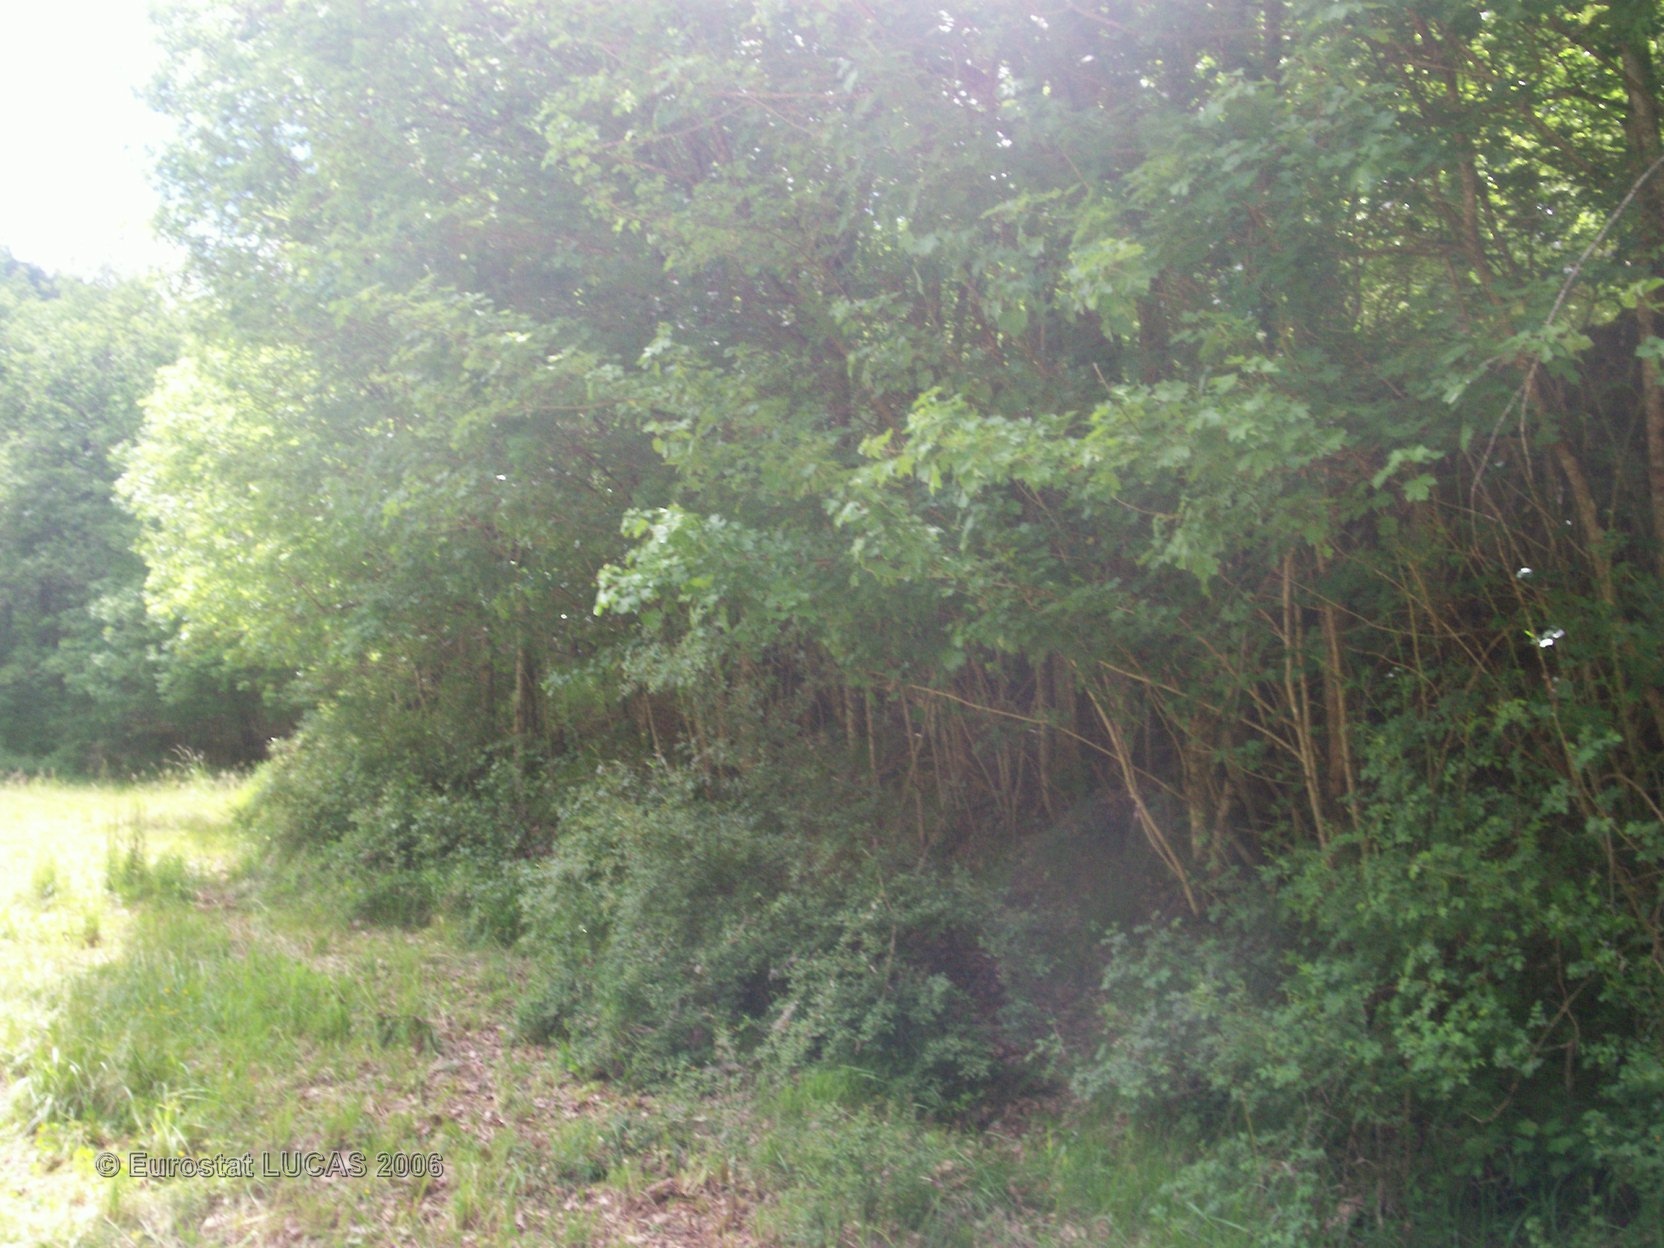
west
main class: Grassland
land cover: Grassland without tree/shrub cover
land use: Agriculture (excluding fallow land and kitchen gardens)
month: June
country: FR
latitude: 44.5202
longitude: 3.3998
